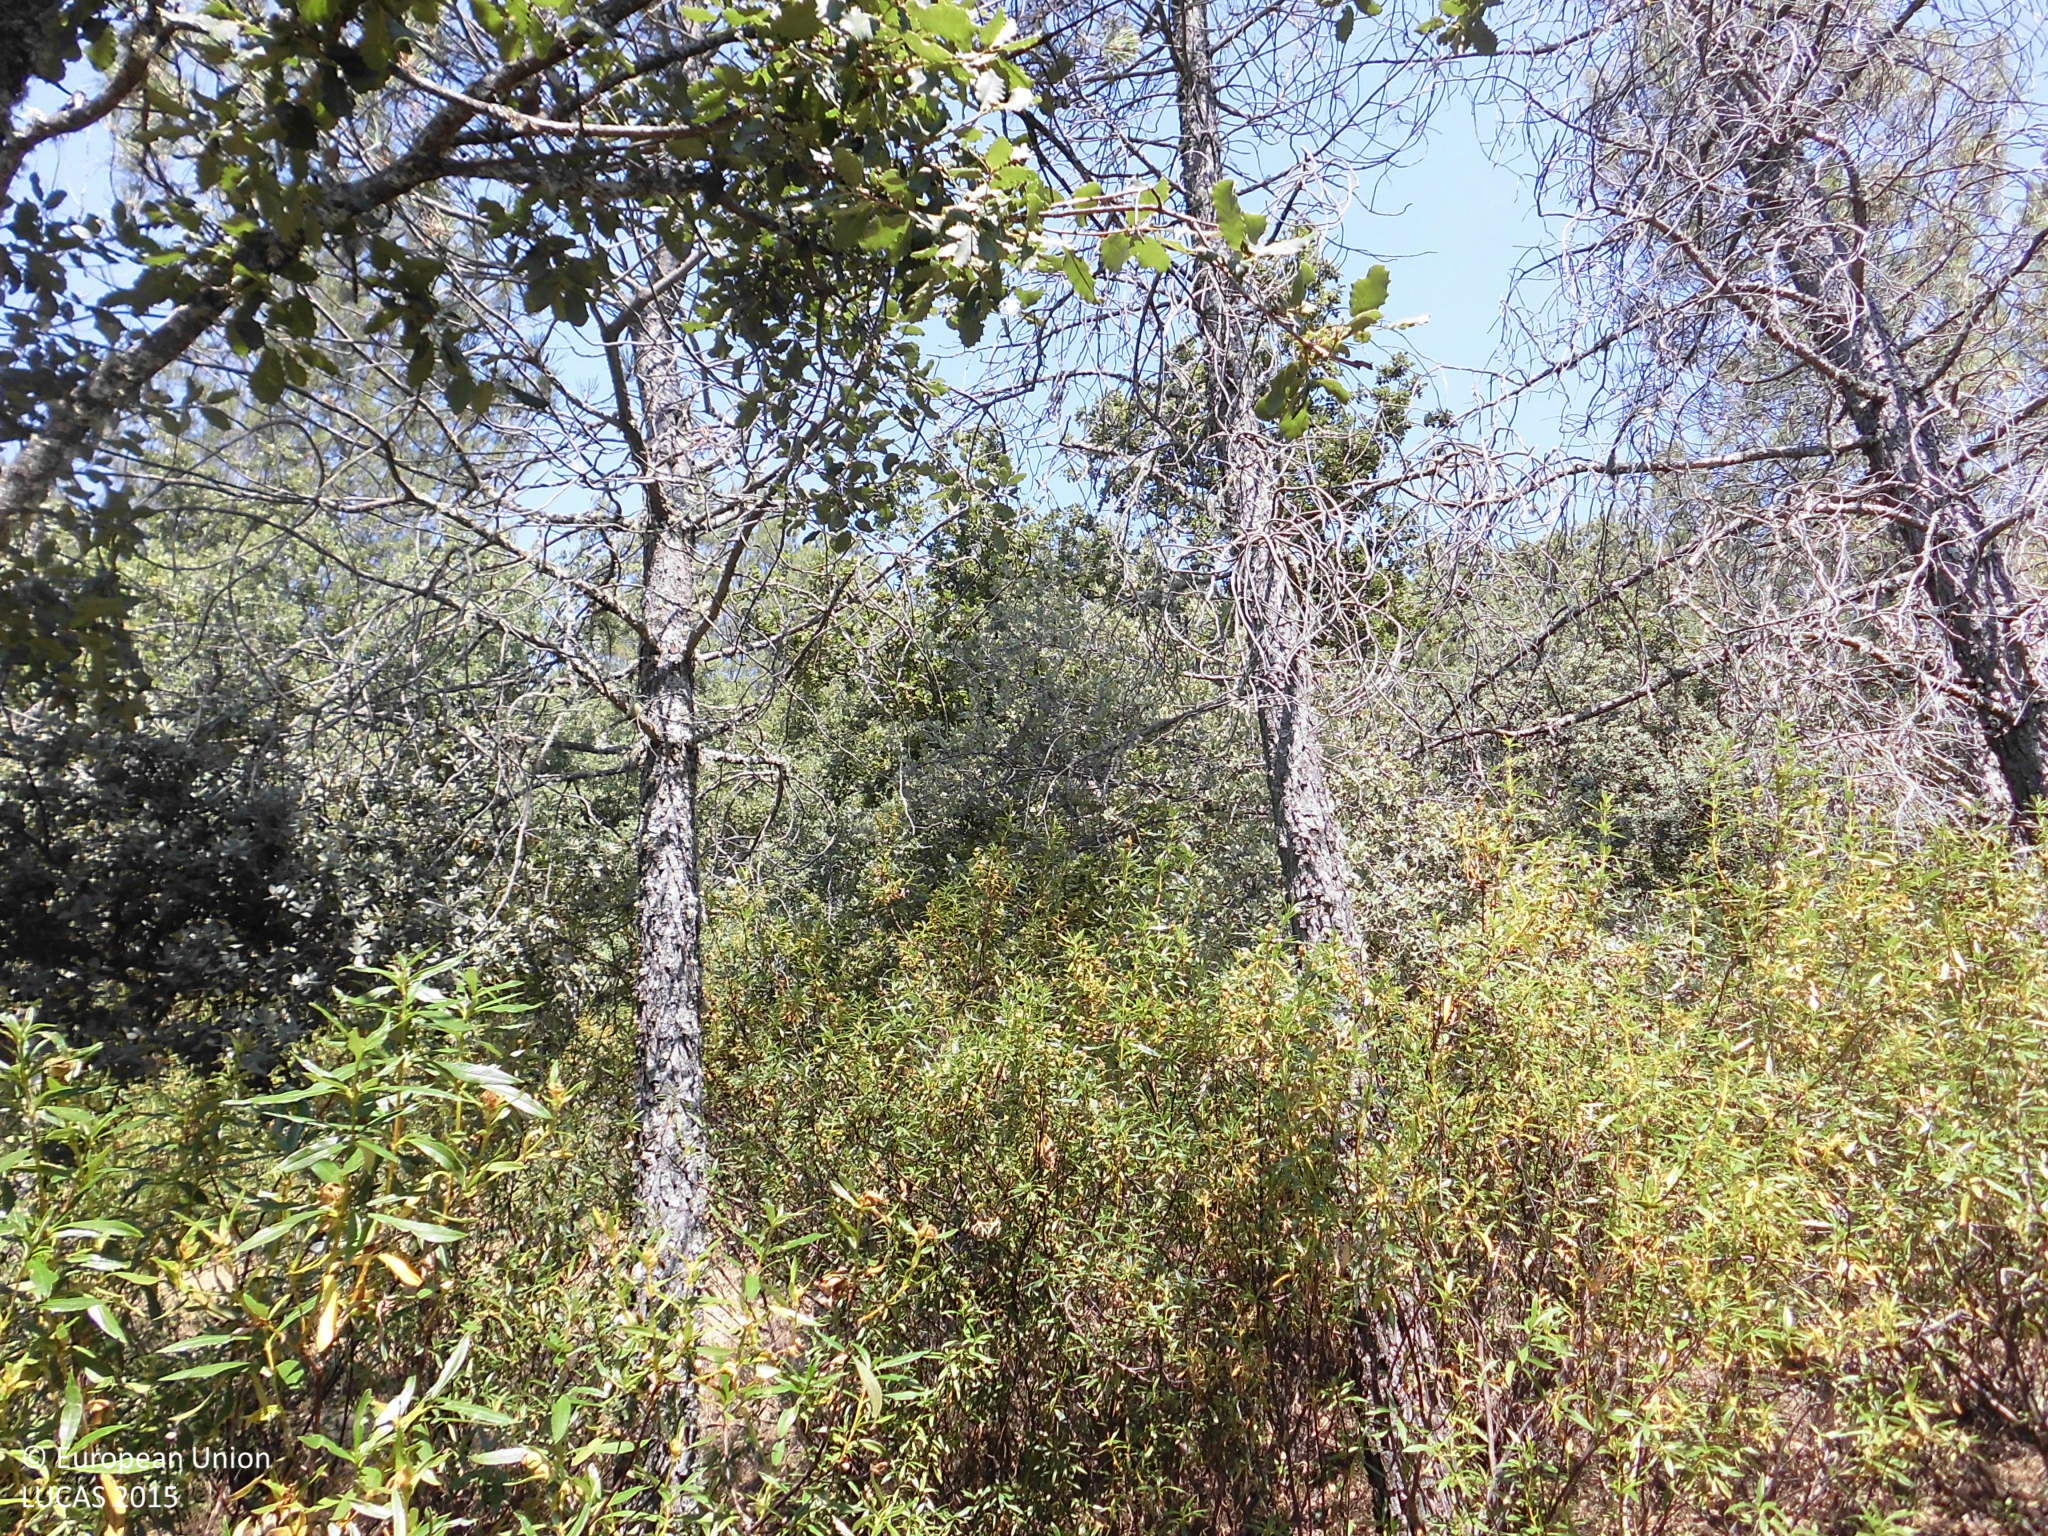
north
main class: Woodland
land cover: Pine dominated mixed woodland
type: coniferous forest of the mediterranean region
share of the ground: > 75 %
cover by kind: coniferous forest trees 40 %, broadleaved forest trees 30 %, shrubs 20 %, herbaceous plants 10 %
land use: Semi-natural and natural areas not in use
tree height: > 5 m
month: June
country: ES
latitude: 39.5472
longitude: -5.3525
